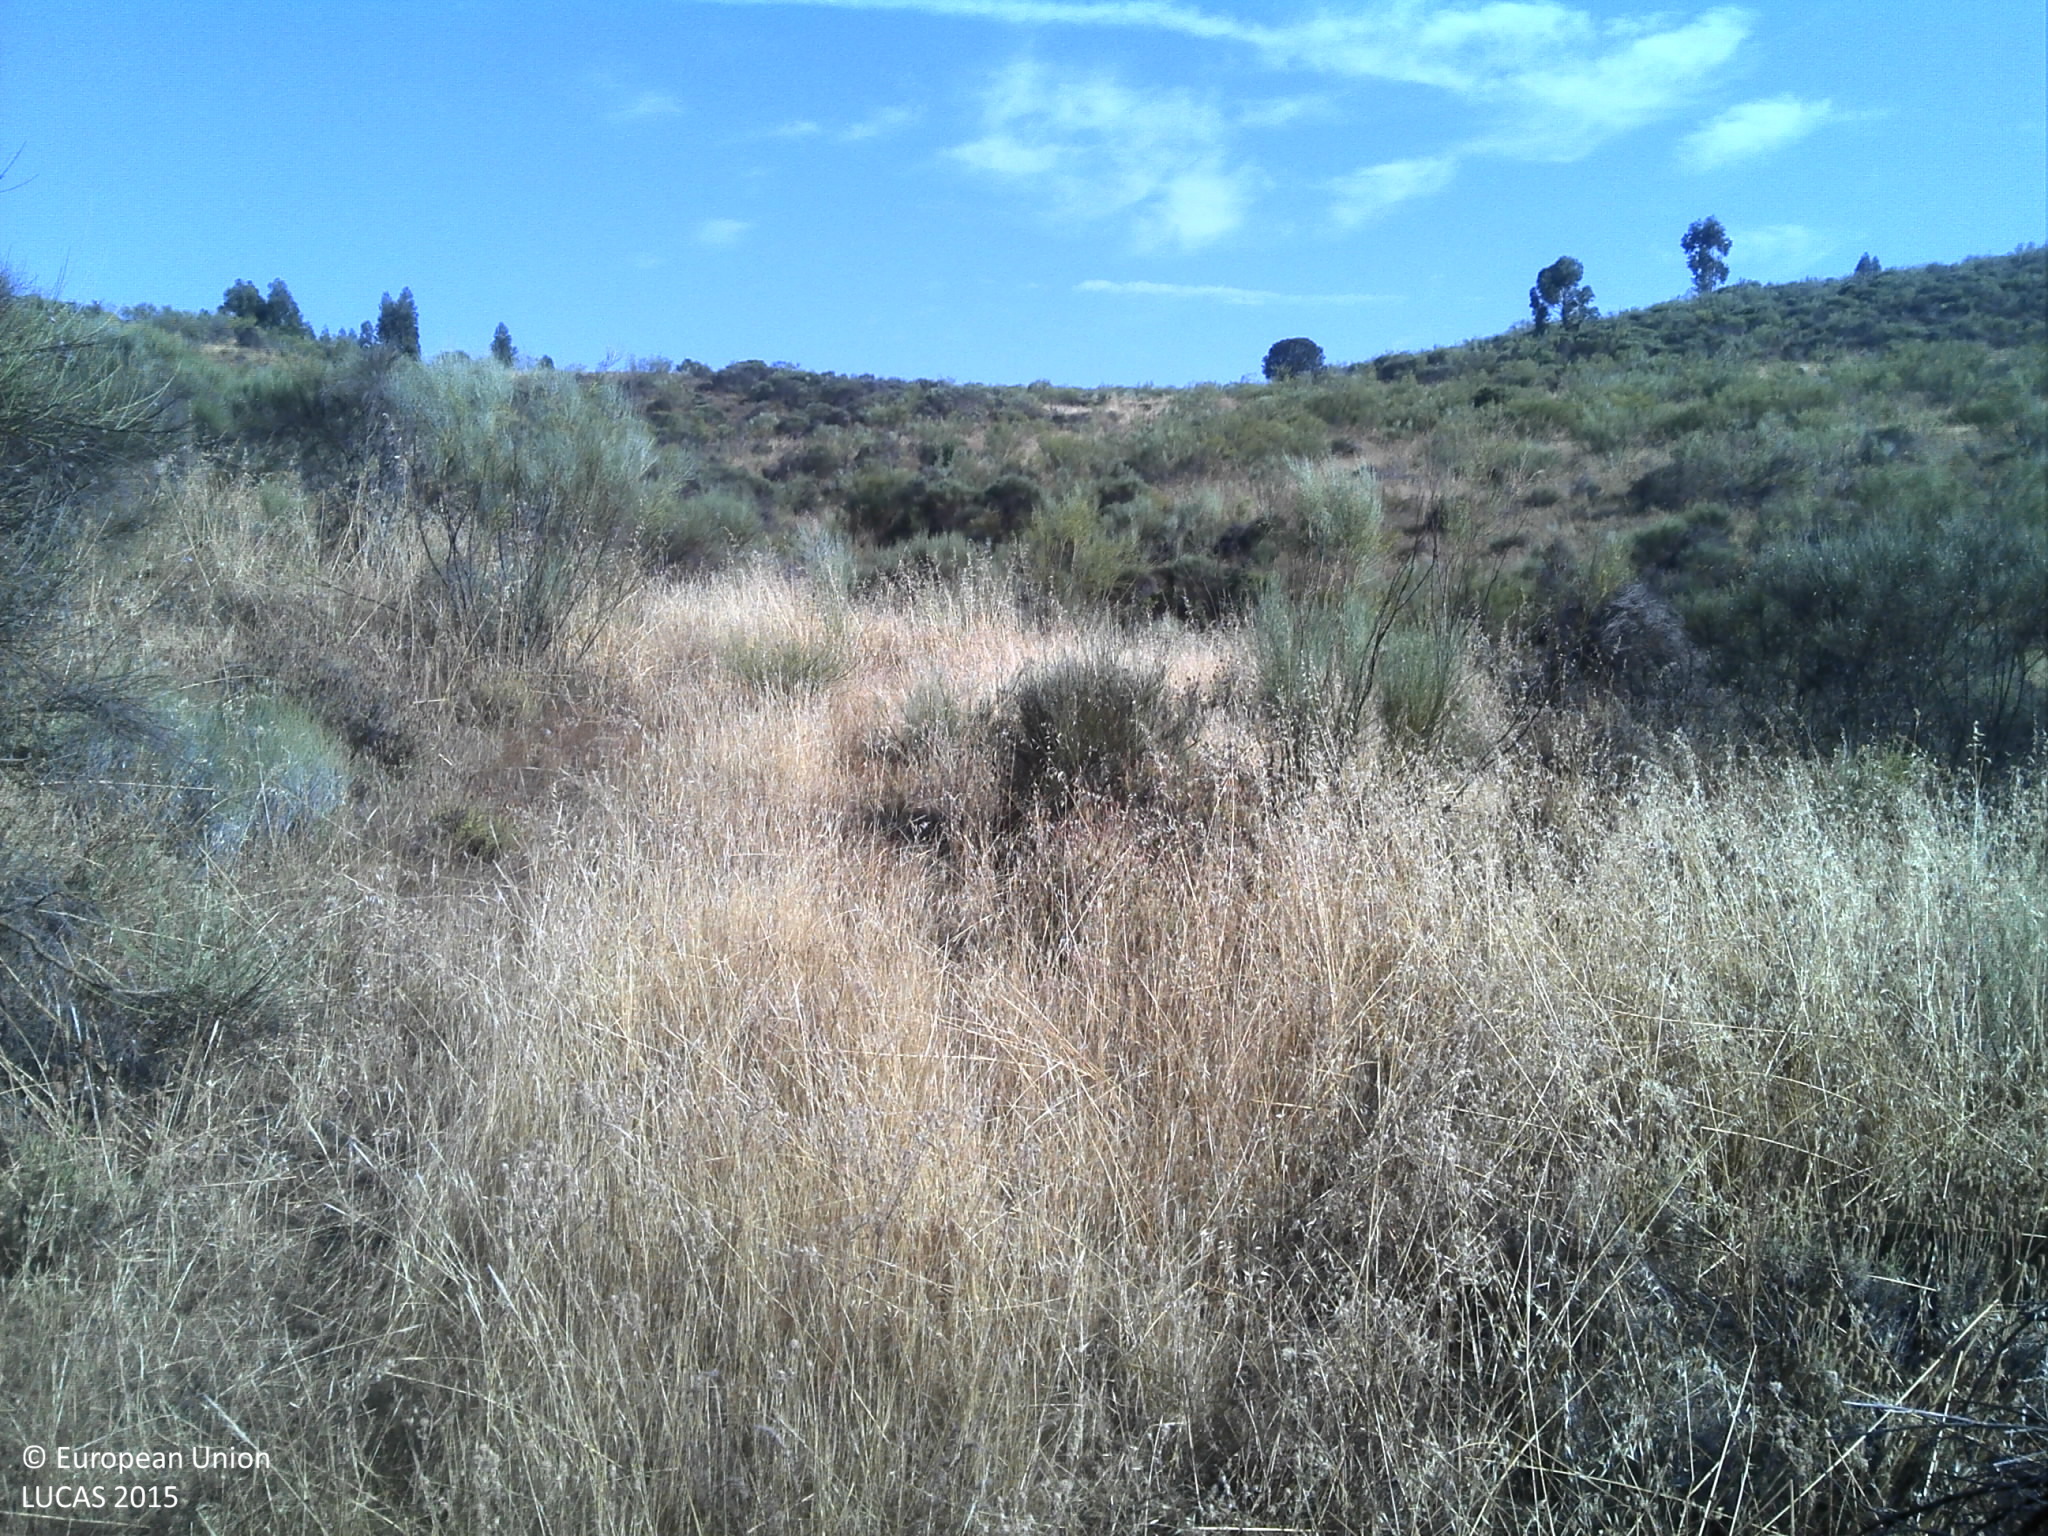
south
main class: Shrubland
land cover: Shrubland without tree cover
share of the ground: 50 - 75 %
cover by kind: shrubs 70 %, herbaceous plants 15 %, unconsolidated bare surface 10 %
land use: Abandoned areas
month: June
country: PT
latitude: 39.8021
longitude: -7.0111
